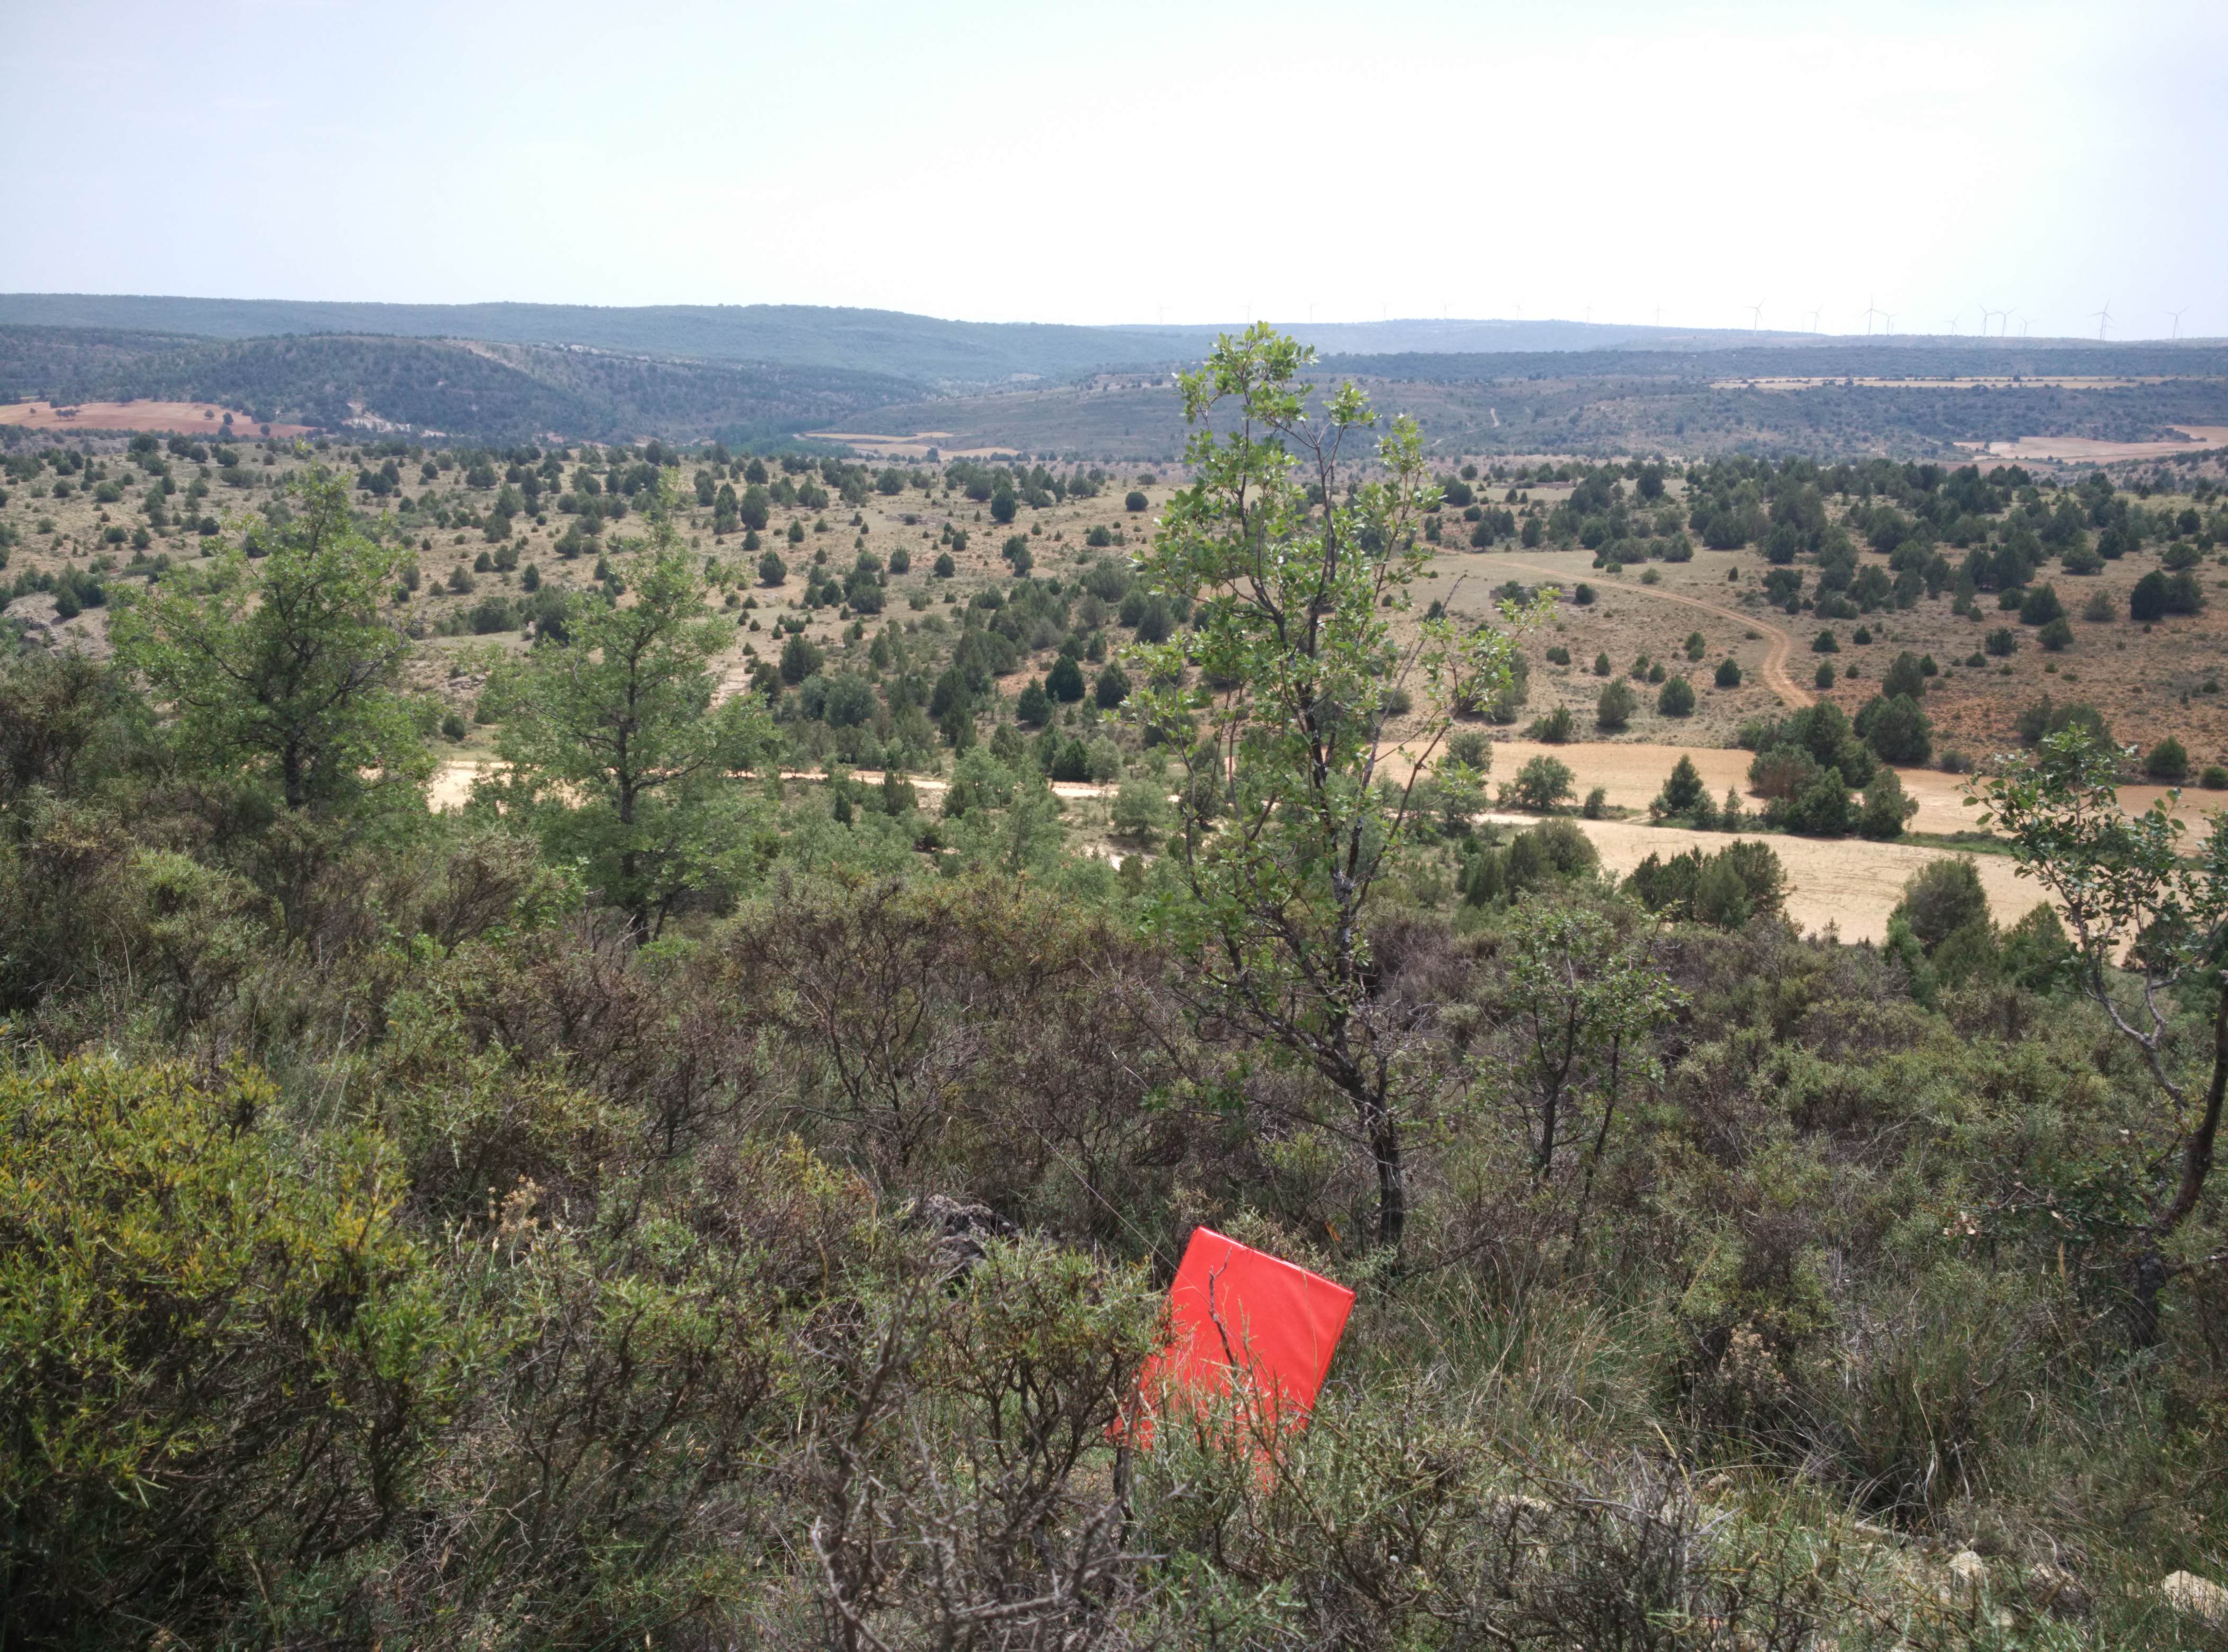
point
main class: Shrubland
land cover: Shrubland with sparse tree cover
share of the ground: > 75 %
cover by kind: shrubs 80 %, unconsolidated bare surface 15 %, broadleaved forest trees 5 %
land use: Semi-natural and natural areas not in use
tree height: > 5 m
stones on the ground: > 50 %
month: July
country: ES
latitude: 41.0139
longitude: -2.0954
